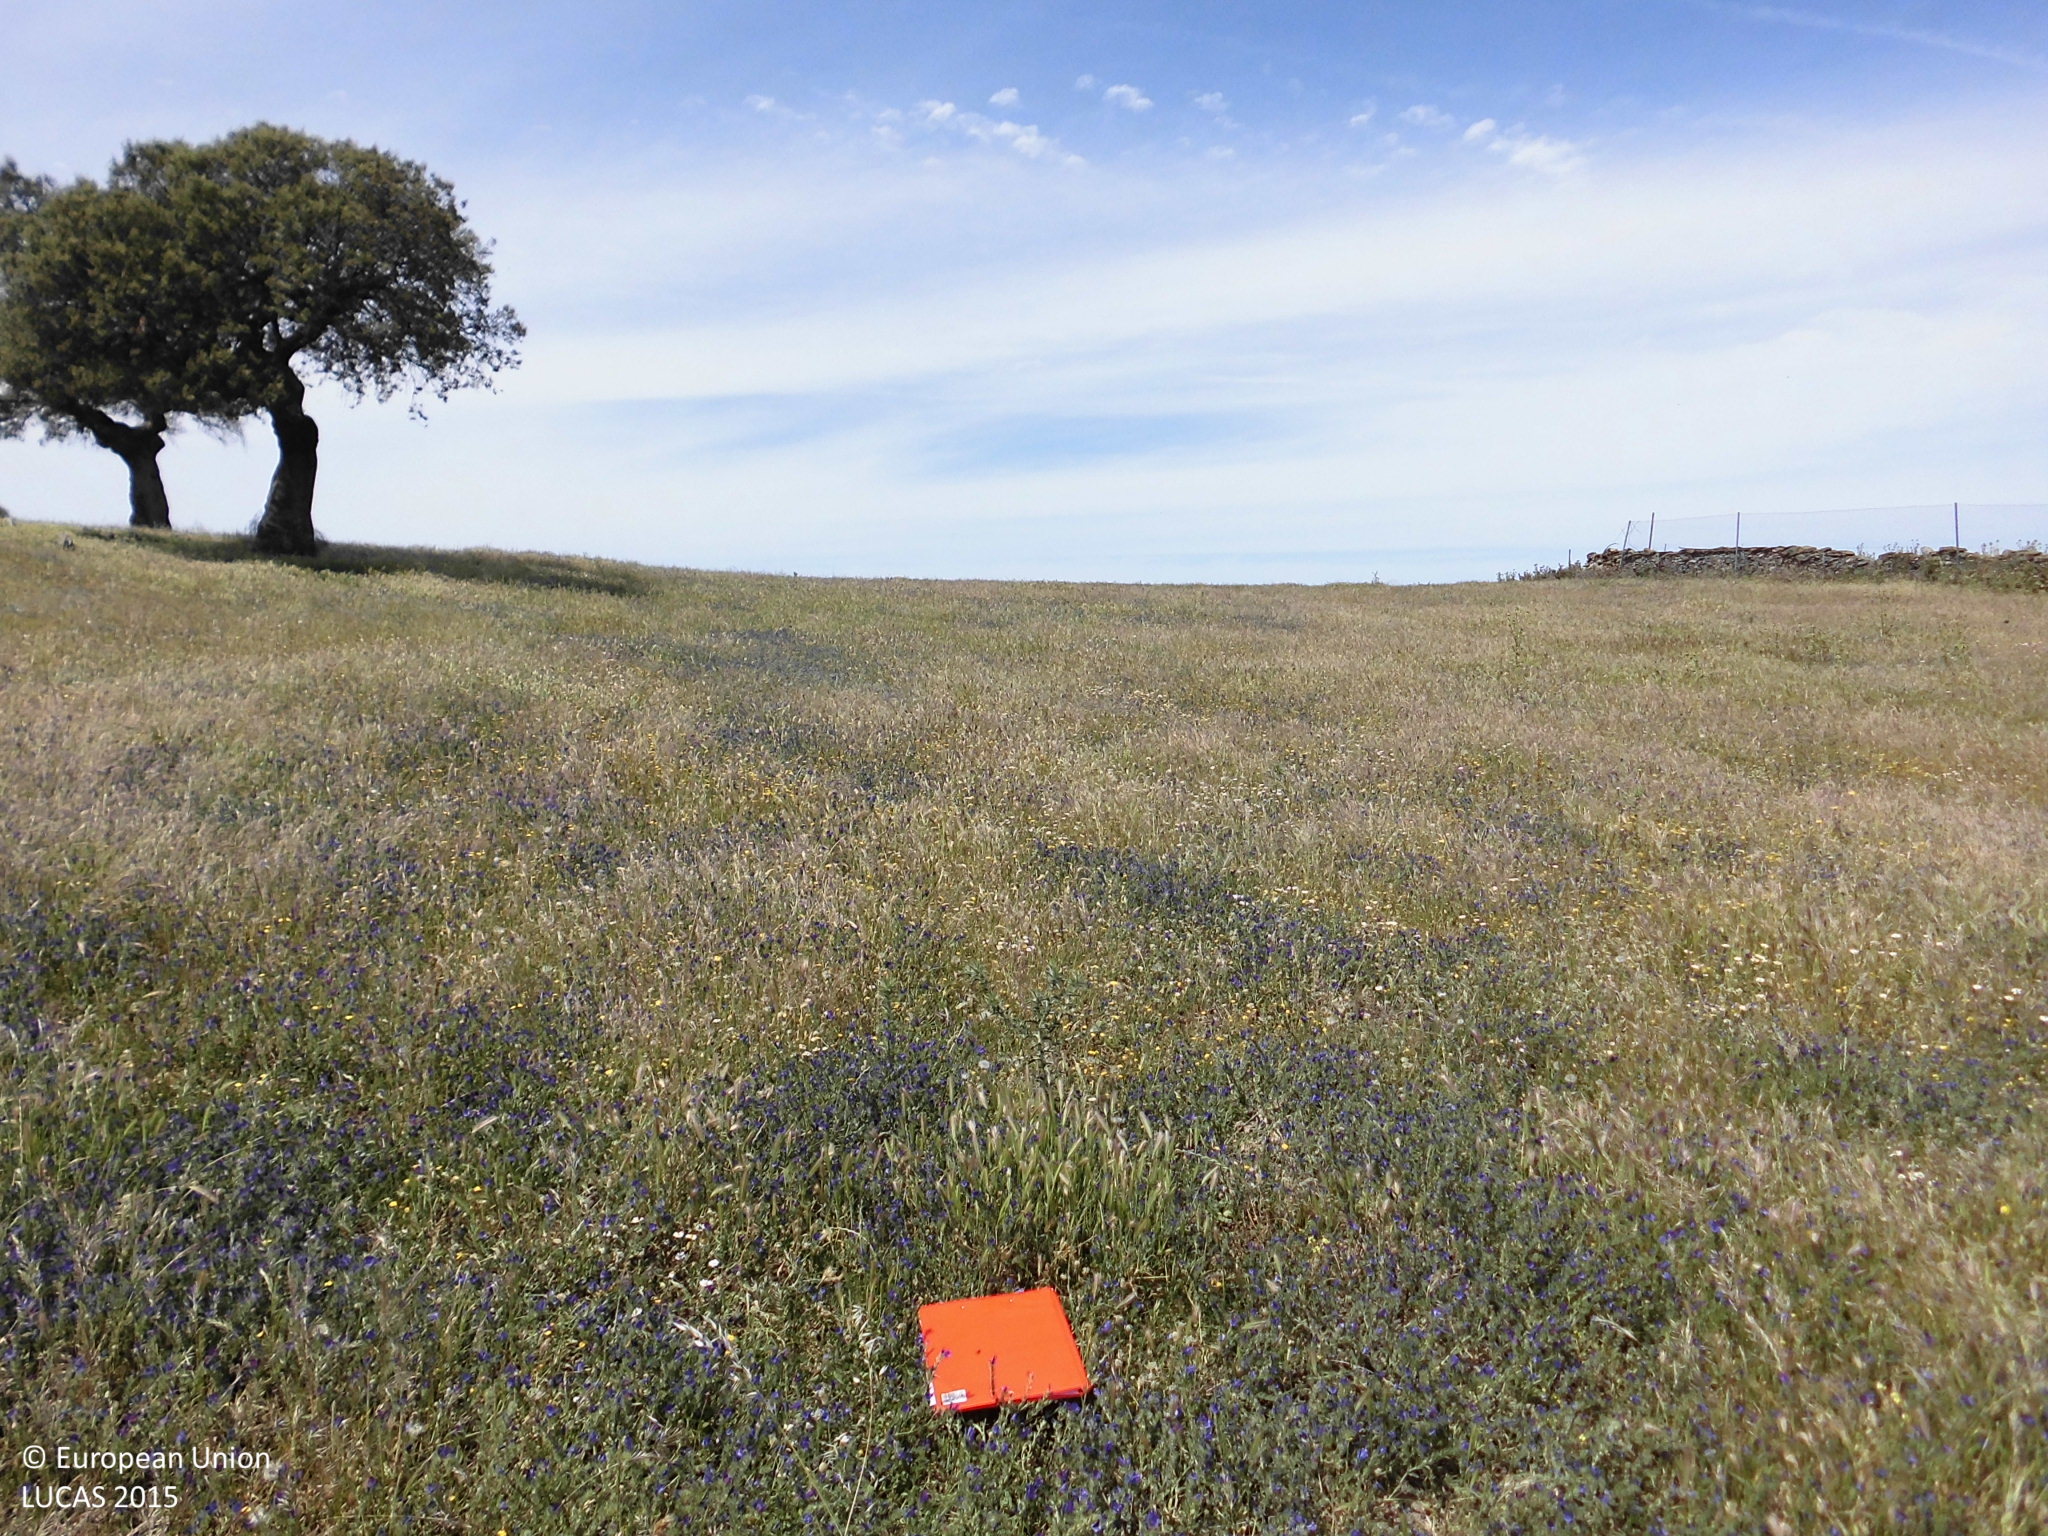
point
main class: Grassland
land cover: Grassland without tree/shrub cover
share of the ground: > 75 %
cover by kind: herbaceous plants 100 %
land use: Agriculture (excluding fallow land and kitchen gardens)
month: May
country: ES
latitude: 39.5368
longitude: -6.4172
